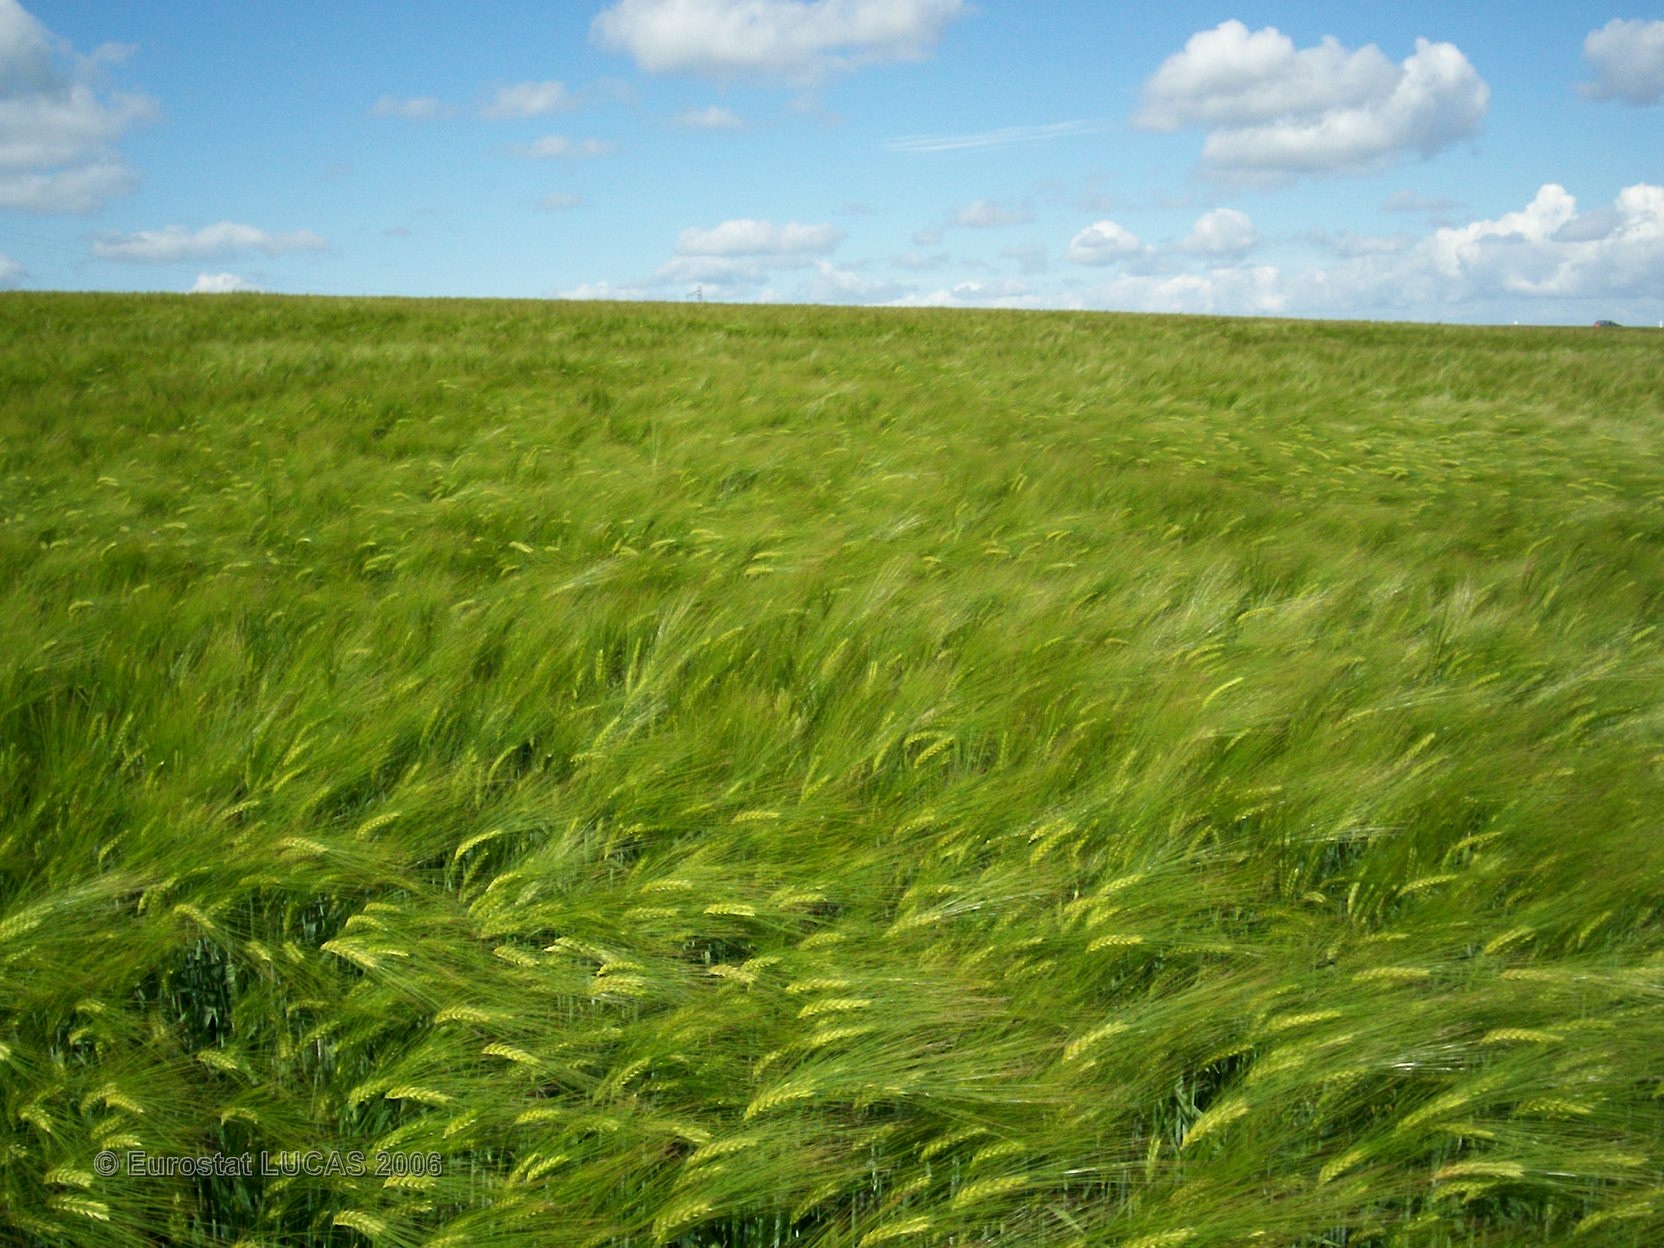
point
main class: Cropland
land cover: Barley
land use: Agriculture (excluding fallow land and kitchen gardens)
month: May
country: FR
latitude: 48.1777
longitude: 4.5242
